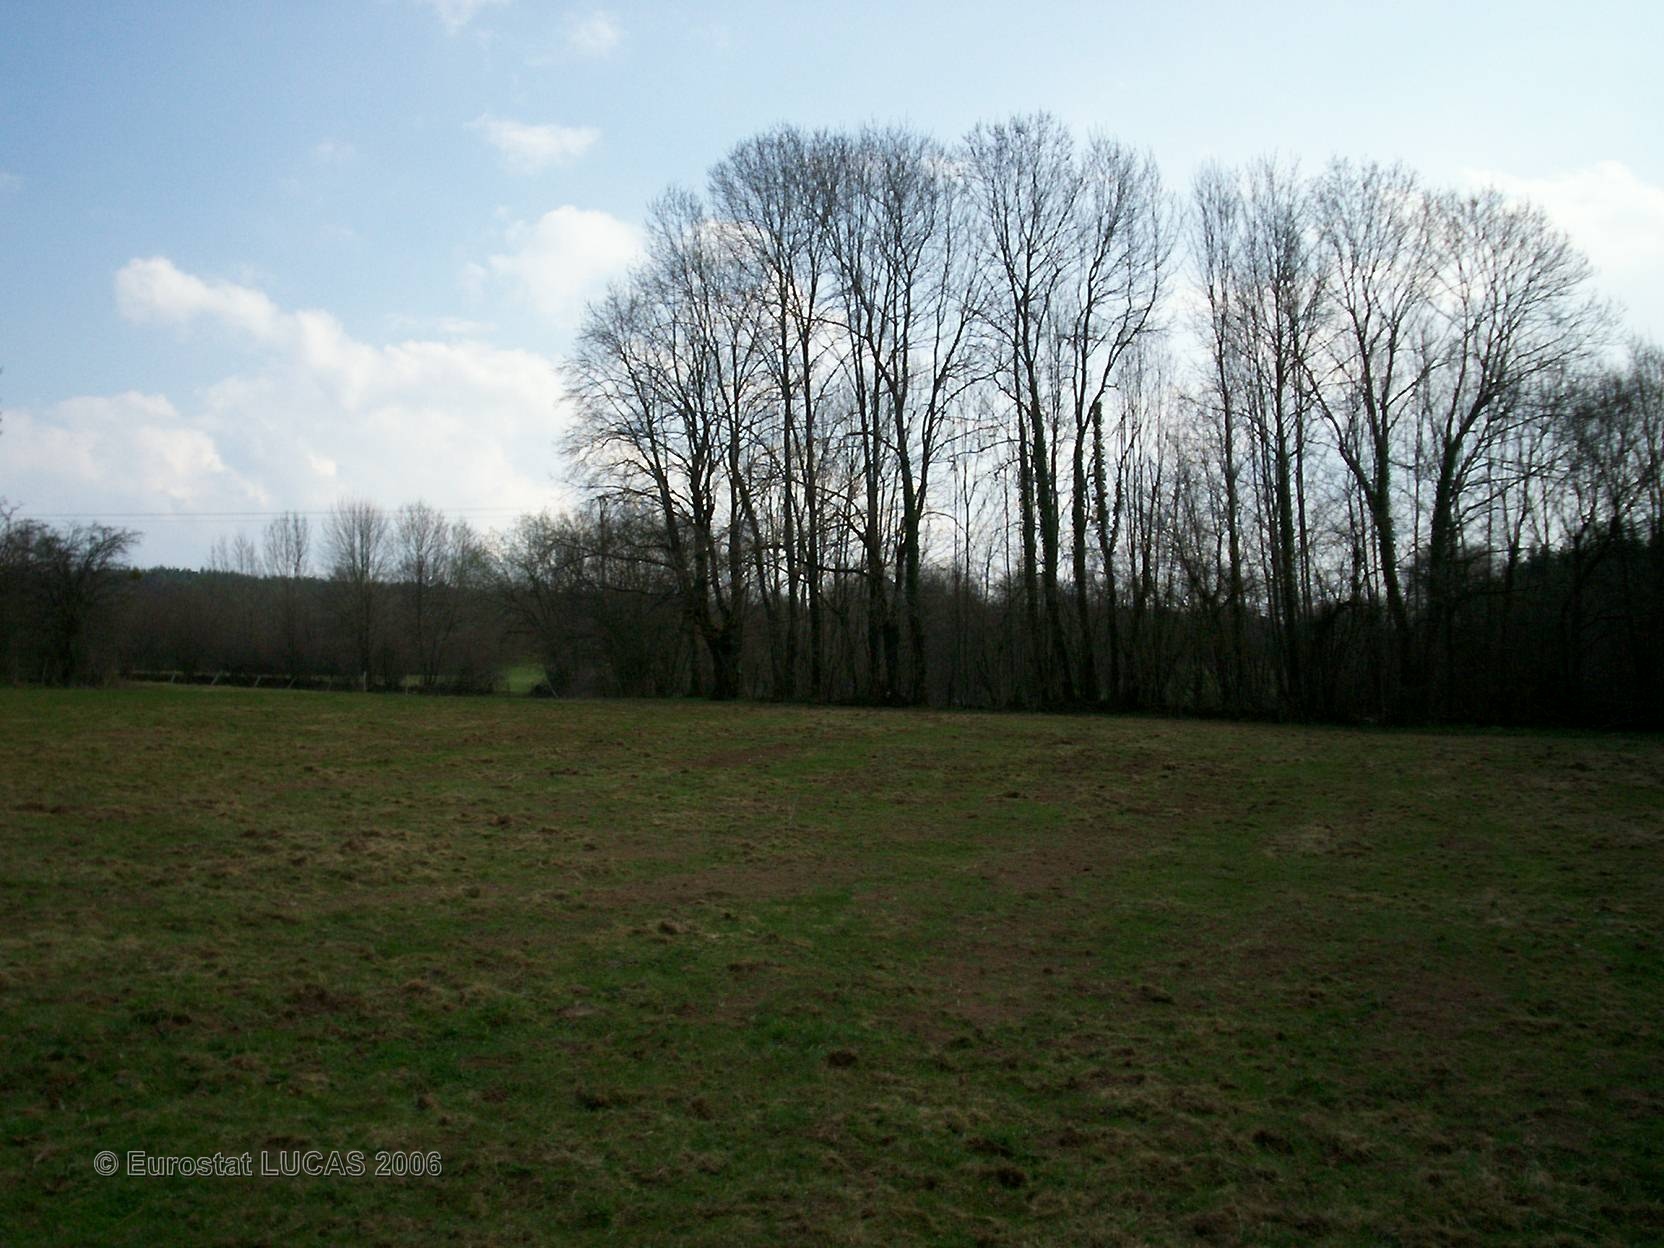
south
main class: Grassland
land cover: Grassland without tree/shrub cover
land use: Agriculture (excluding fallow land and kitchen gardens)
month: April
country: FR
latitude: 47.2526
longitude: 6.6061
